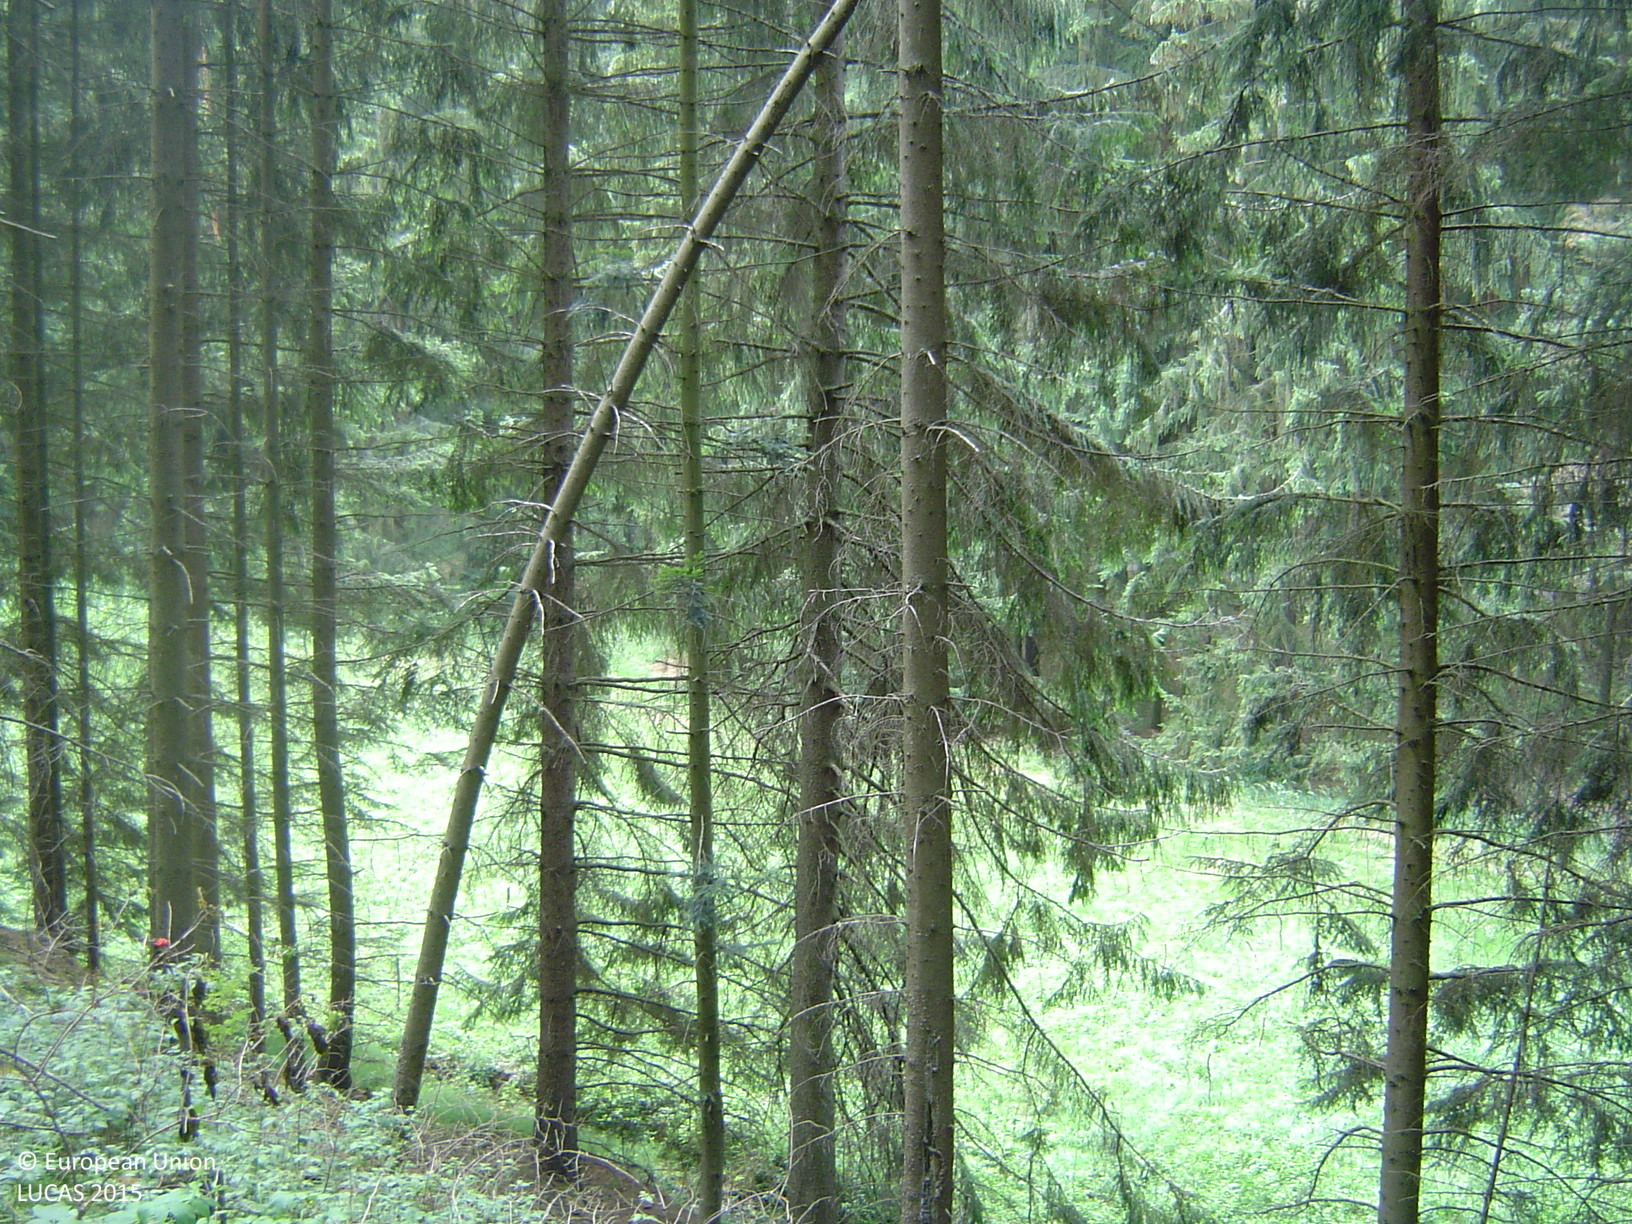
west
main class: Woodland
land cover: Spruce dominated coniferous woodland
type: hemiboreal forest and nemoral coniferous forest and mixed broadleaved-coniferous forest
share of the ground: > 75 %
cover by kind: coniferous forest trees 90 %, shrubs 5 %, herbaceous plants 5 %
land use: Forestry
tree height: > 5 m
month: July
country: CZ
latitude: 49.2906
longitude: 16.2620
